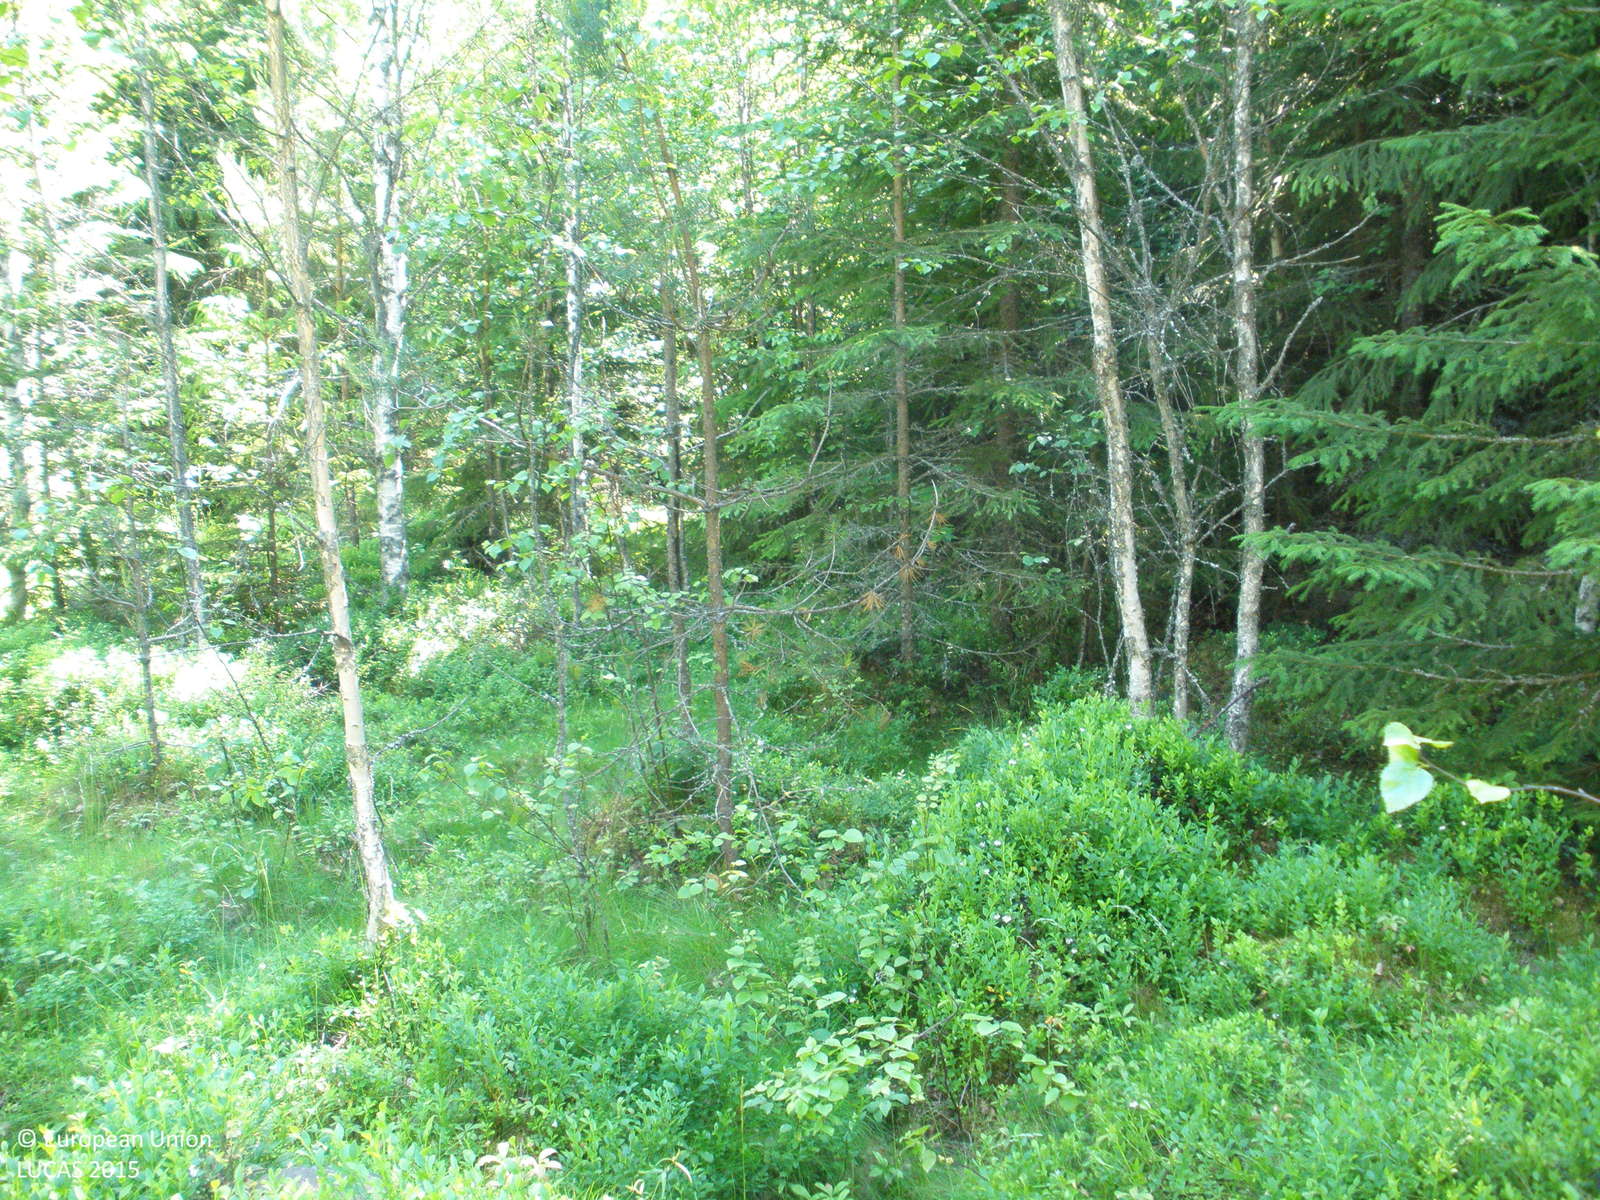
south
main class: Woodland
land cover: Spruce dominated mixed woodland
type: boreal forest
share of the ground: > 75 %
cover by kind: broadleaved forest trees 40 %, coniferous forest trees 35 %, herbaceous plants 25 %
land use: Forestry
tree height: > 5 m
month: July
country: FI
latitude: 61.1140
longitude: 23.7639
